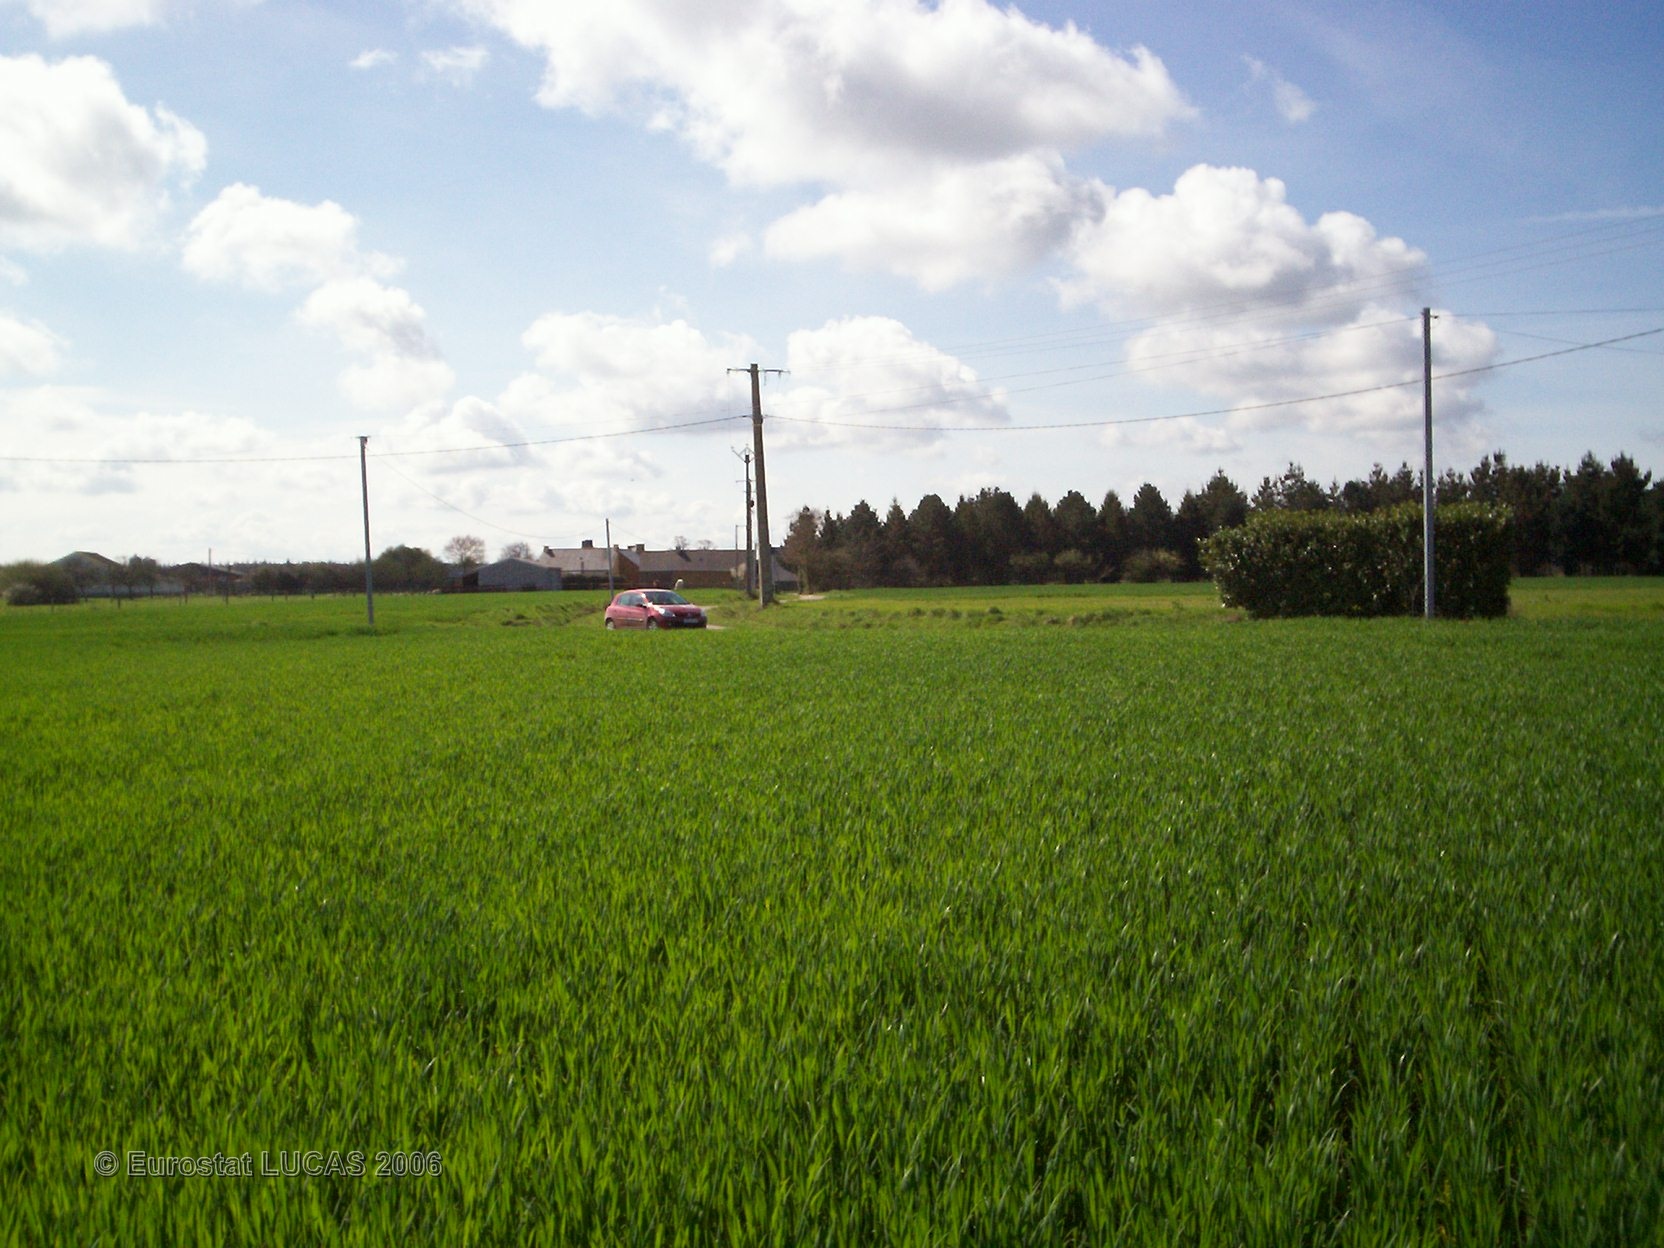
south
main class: Cropland
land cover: Barley
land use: Agriculture (excluding fallow land and kitchen gardens)
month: April
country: FR
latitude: 48.5660
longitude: -2.4883
